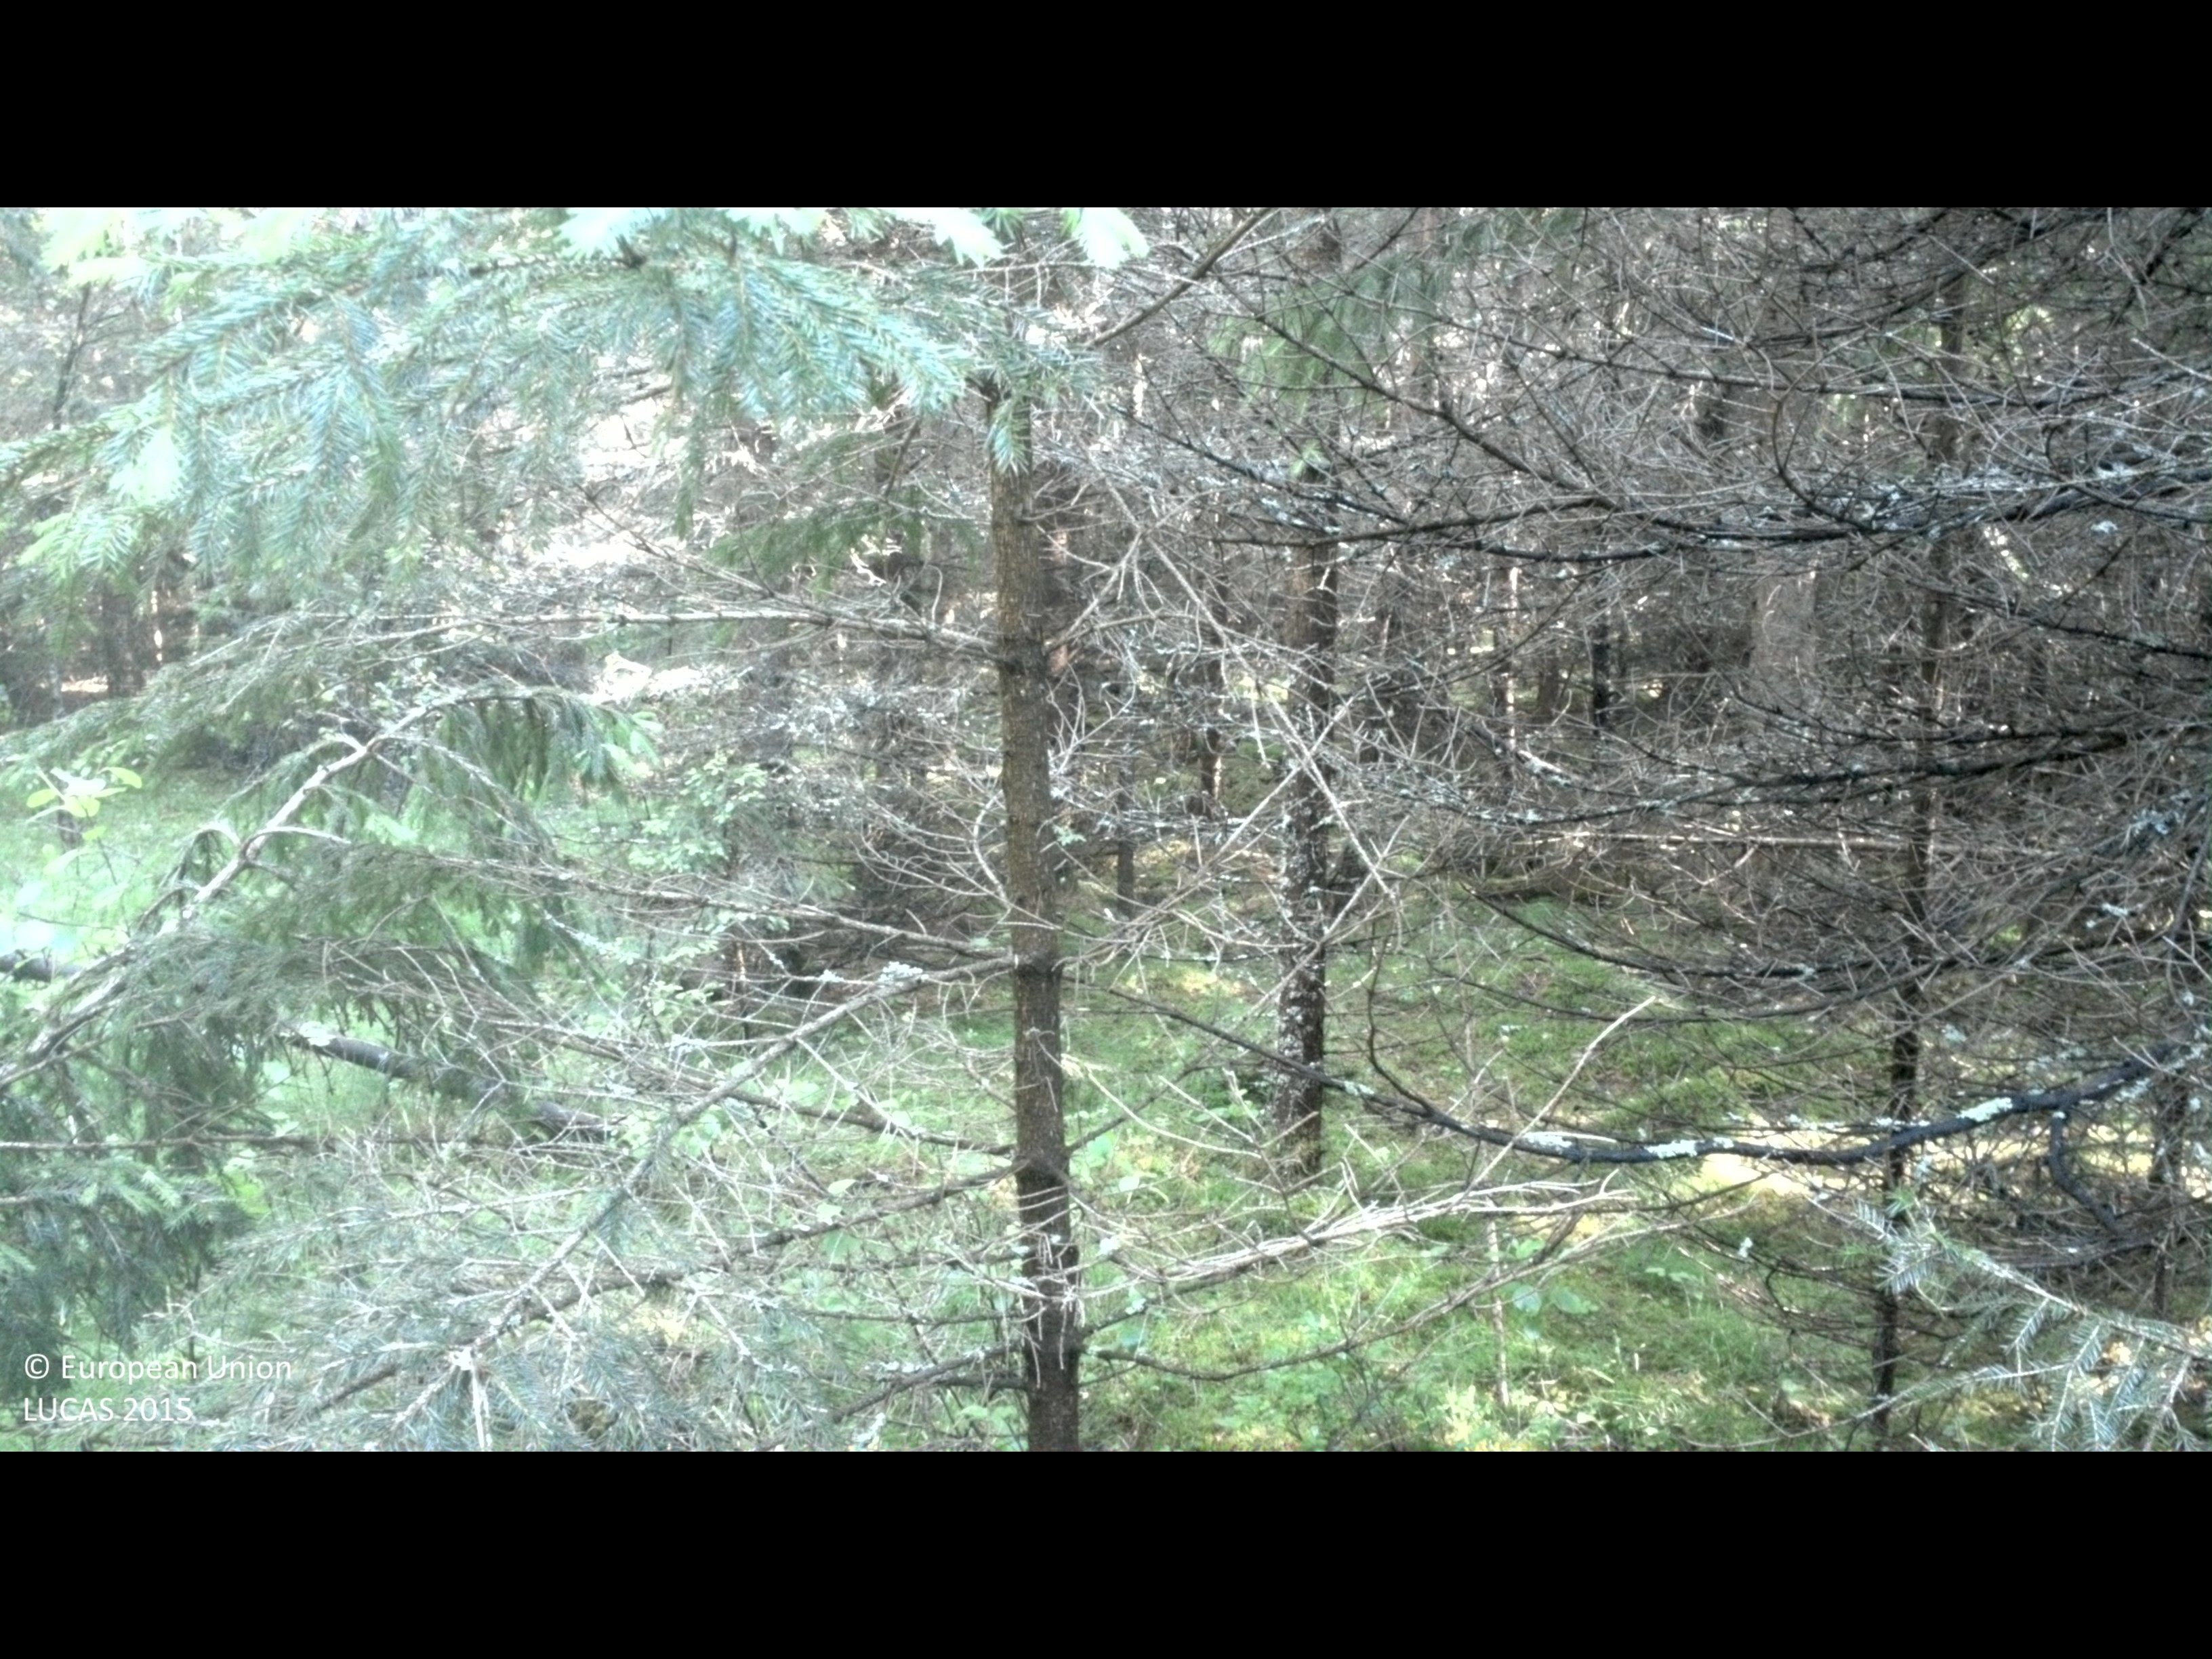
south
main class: Woodland
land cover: Spruce dominated coniferous woodland
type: boreal forest
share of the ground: > 75 %
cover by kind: coniferous forest trees 80 %, broadleaved forest trees 10 %, shrubs 5 %, herbaceous plants 5 %
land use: Forestry
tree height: > 5 m
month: July
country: SE
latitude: 58.4010
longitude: 16.2070
